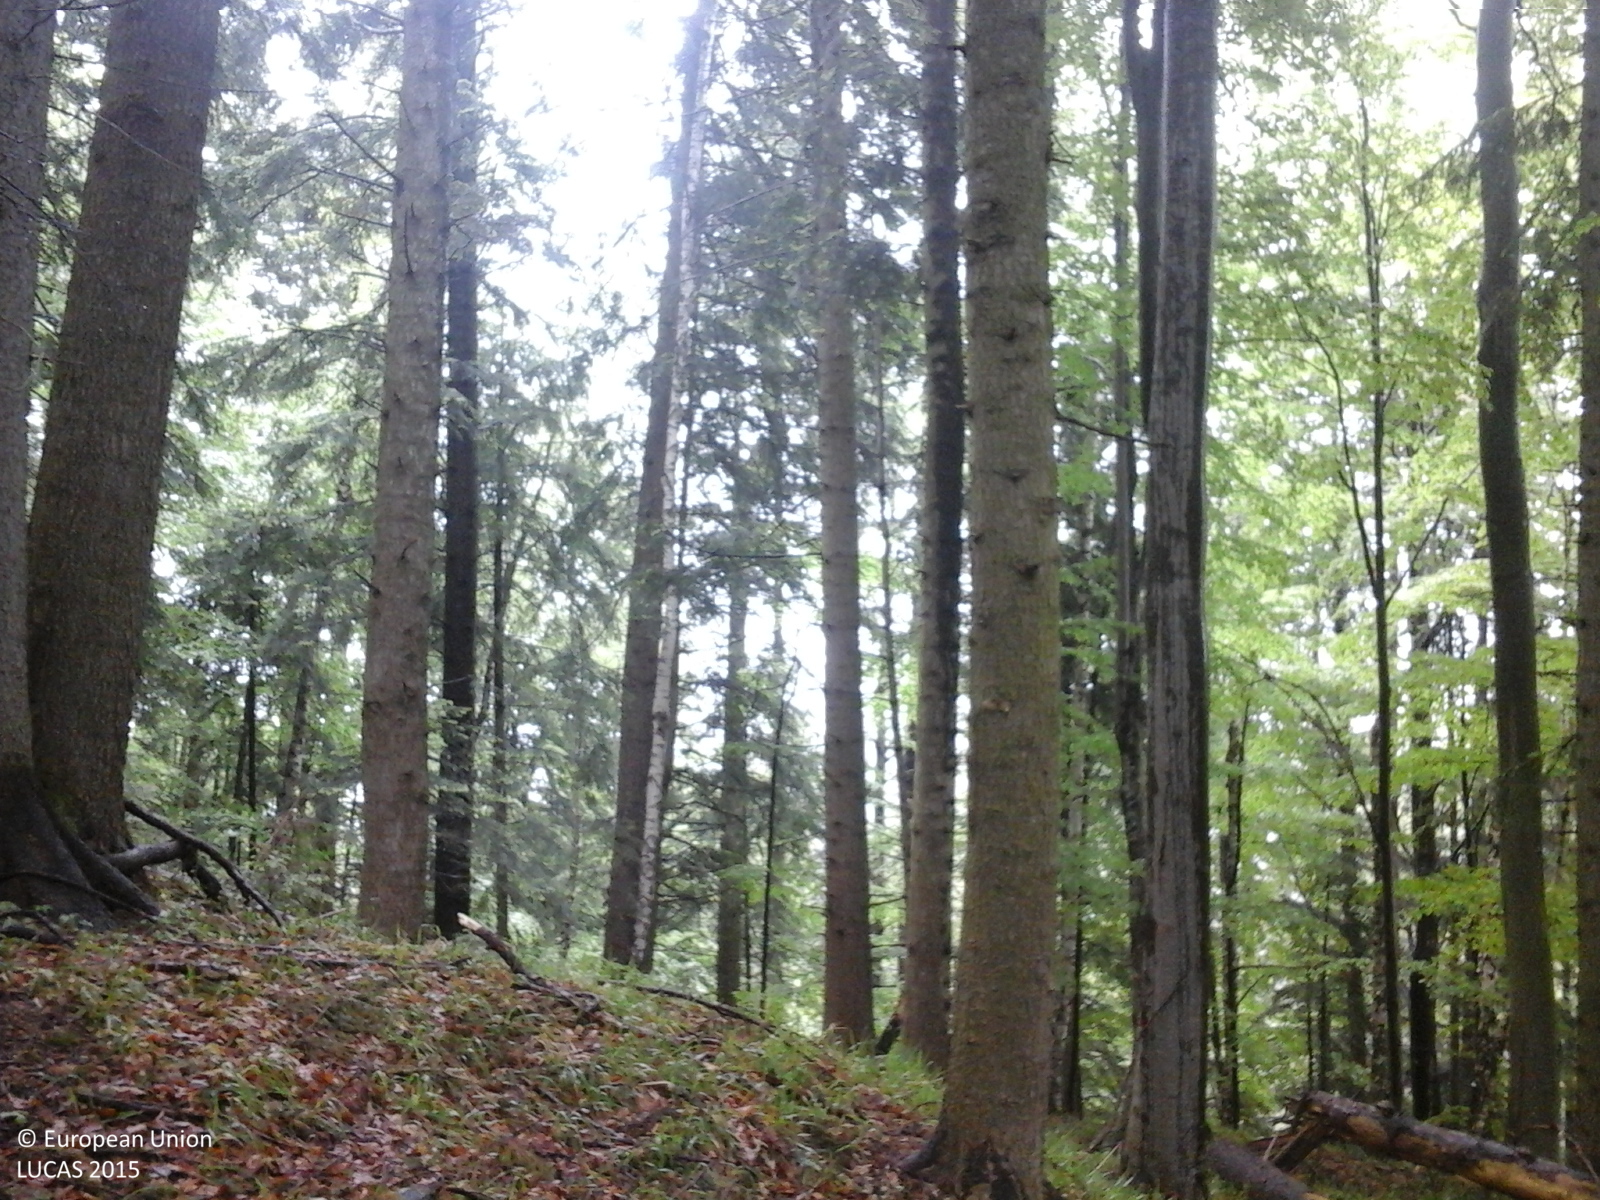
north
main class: Woodland
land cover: Other mixed woodland
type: alpine coniferous forest
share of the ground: > 75 %
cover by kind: coniferous forest trees 65 %, broadleaved forest trees 35 %
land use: Forestry
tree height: > 5 m
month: May
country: RO
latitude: 45.6385
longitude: 25.2213
